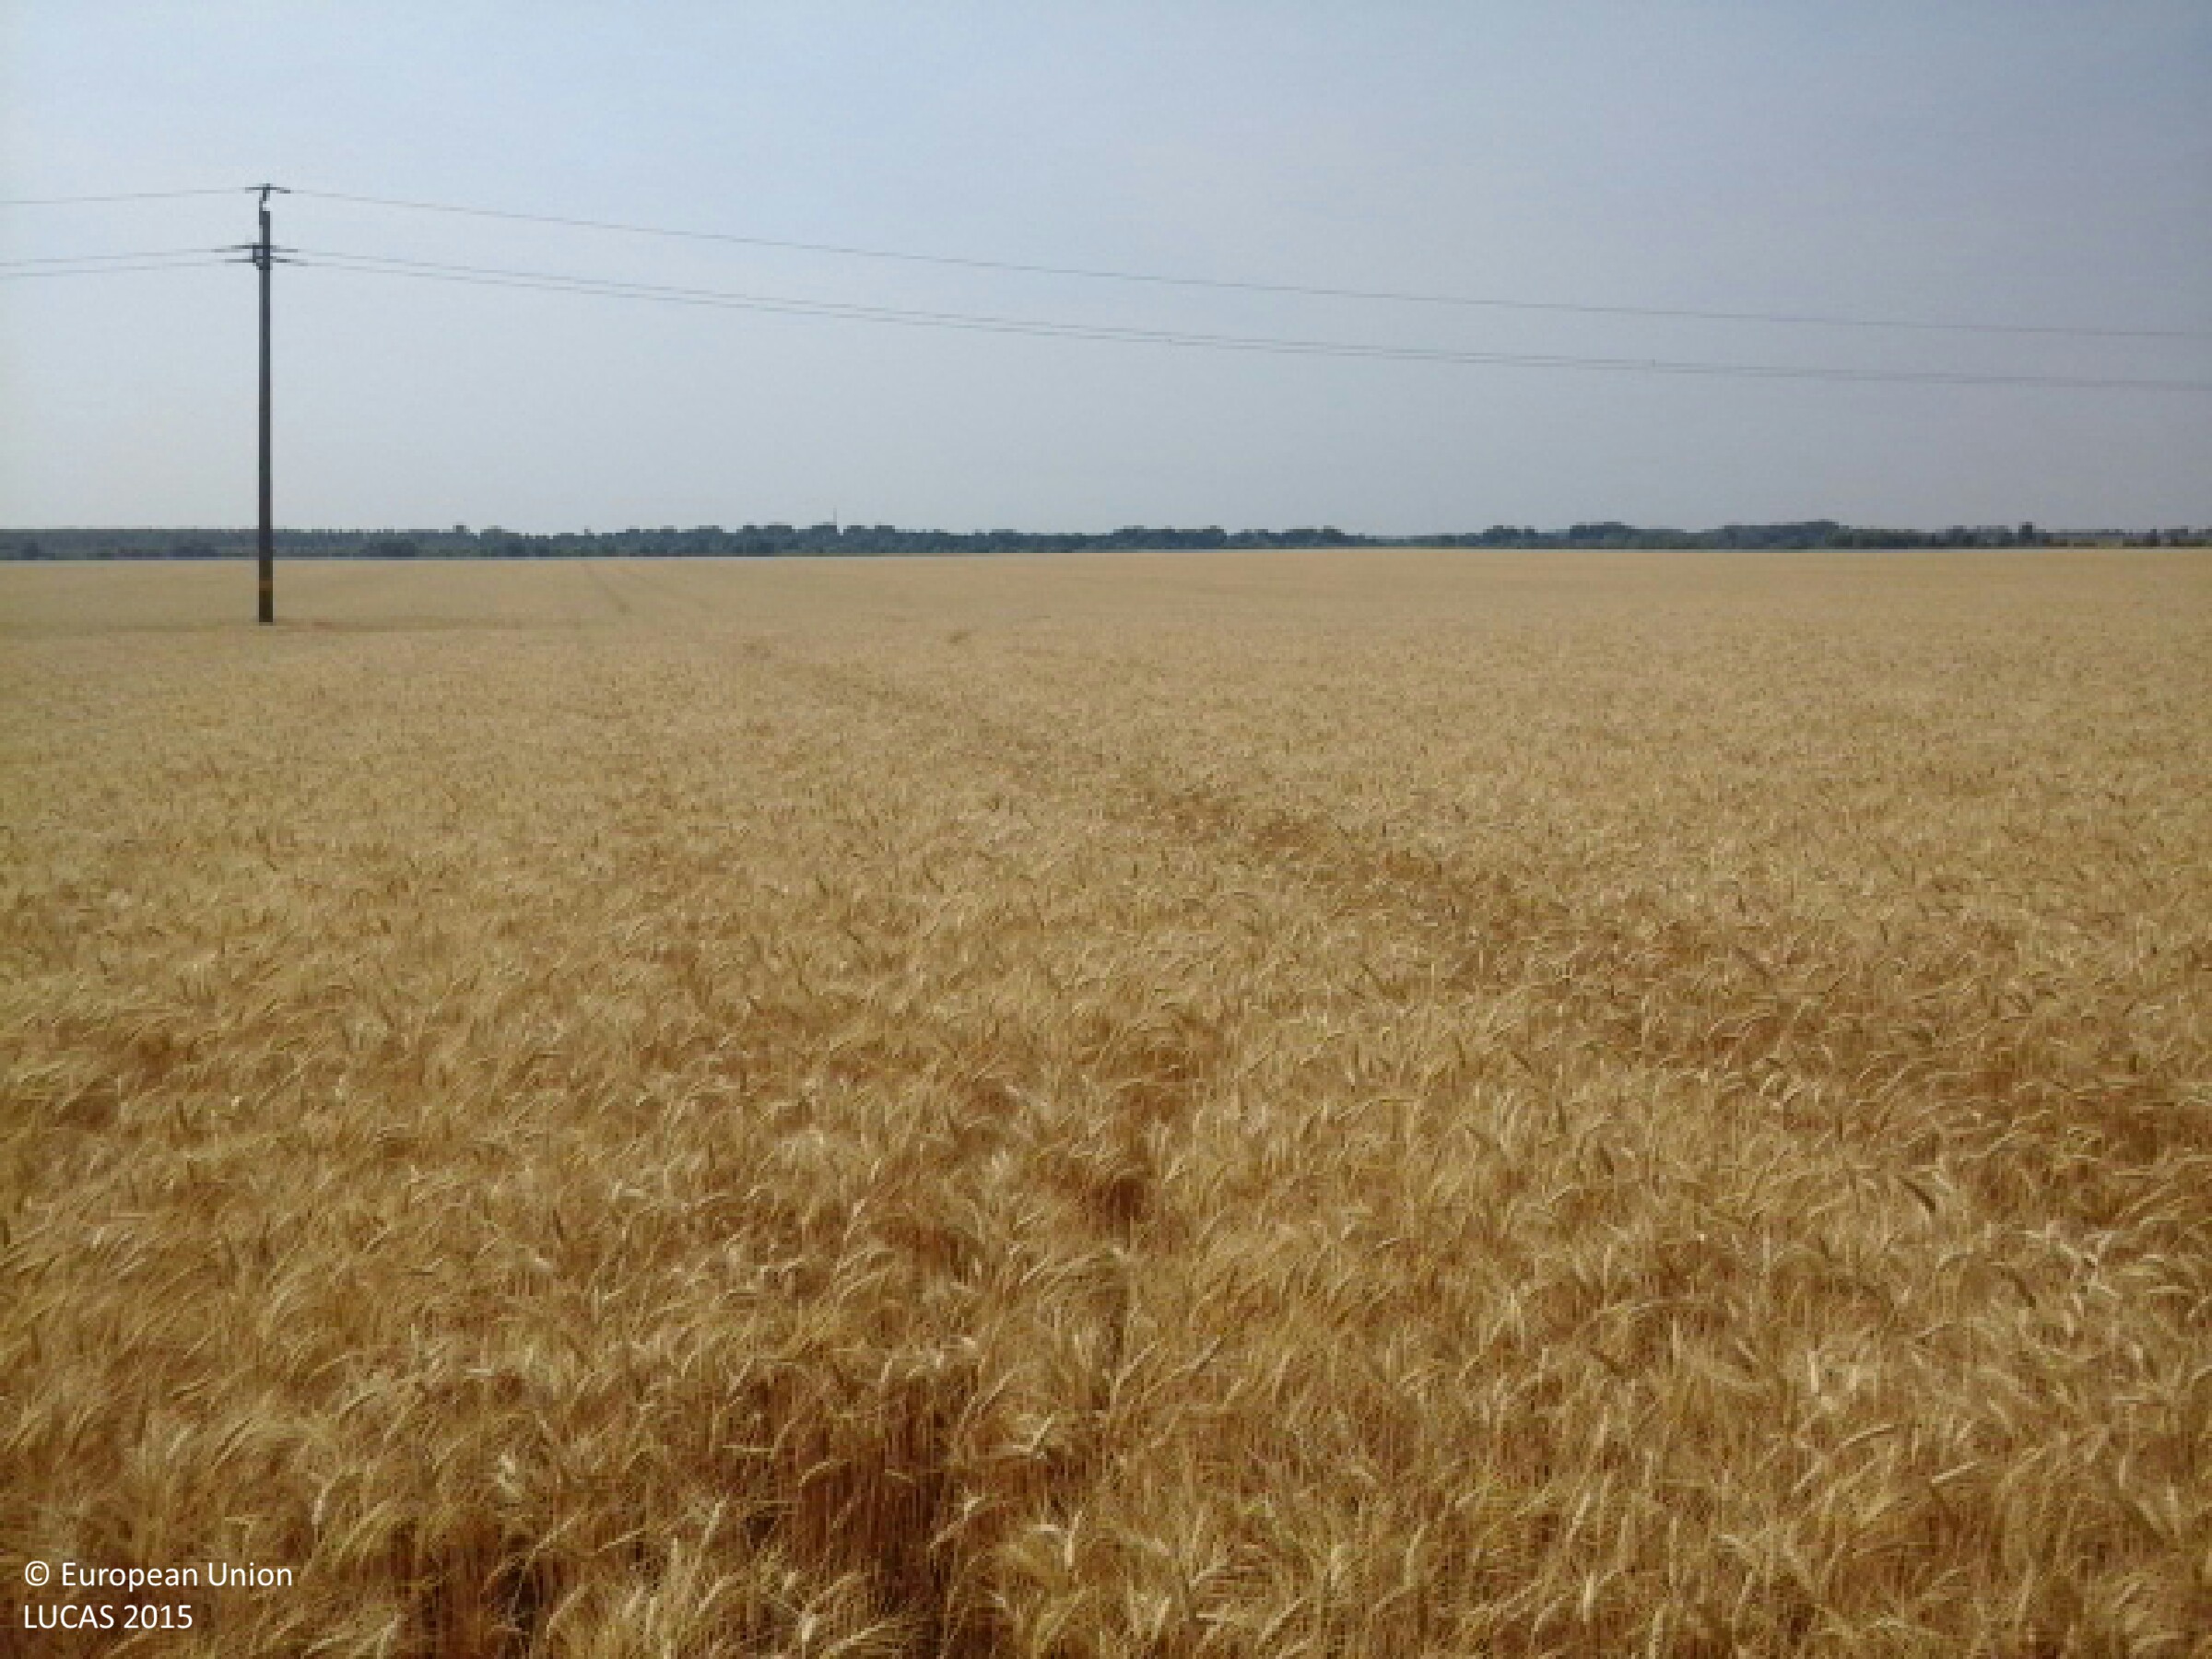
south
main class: Cropland
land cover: Triticale
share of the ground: > 75 %
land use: Agriculture (excluding fallow land and kitchen gardens)
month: July
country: HU
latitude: 48.0295
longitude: 21.0493
